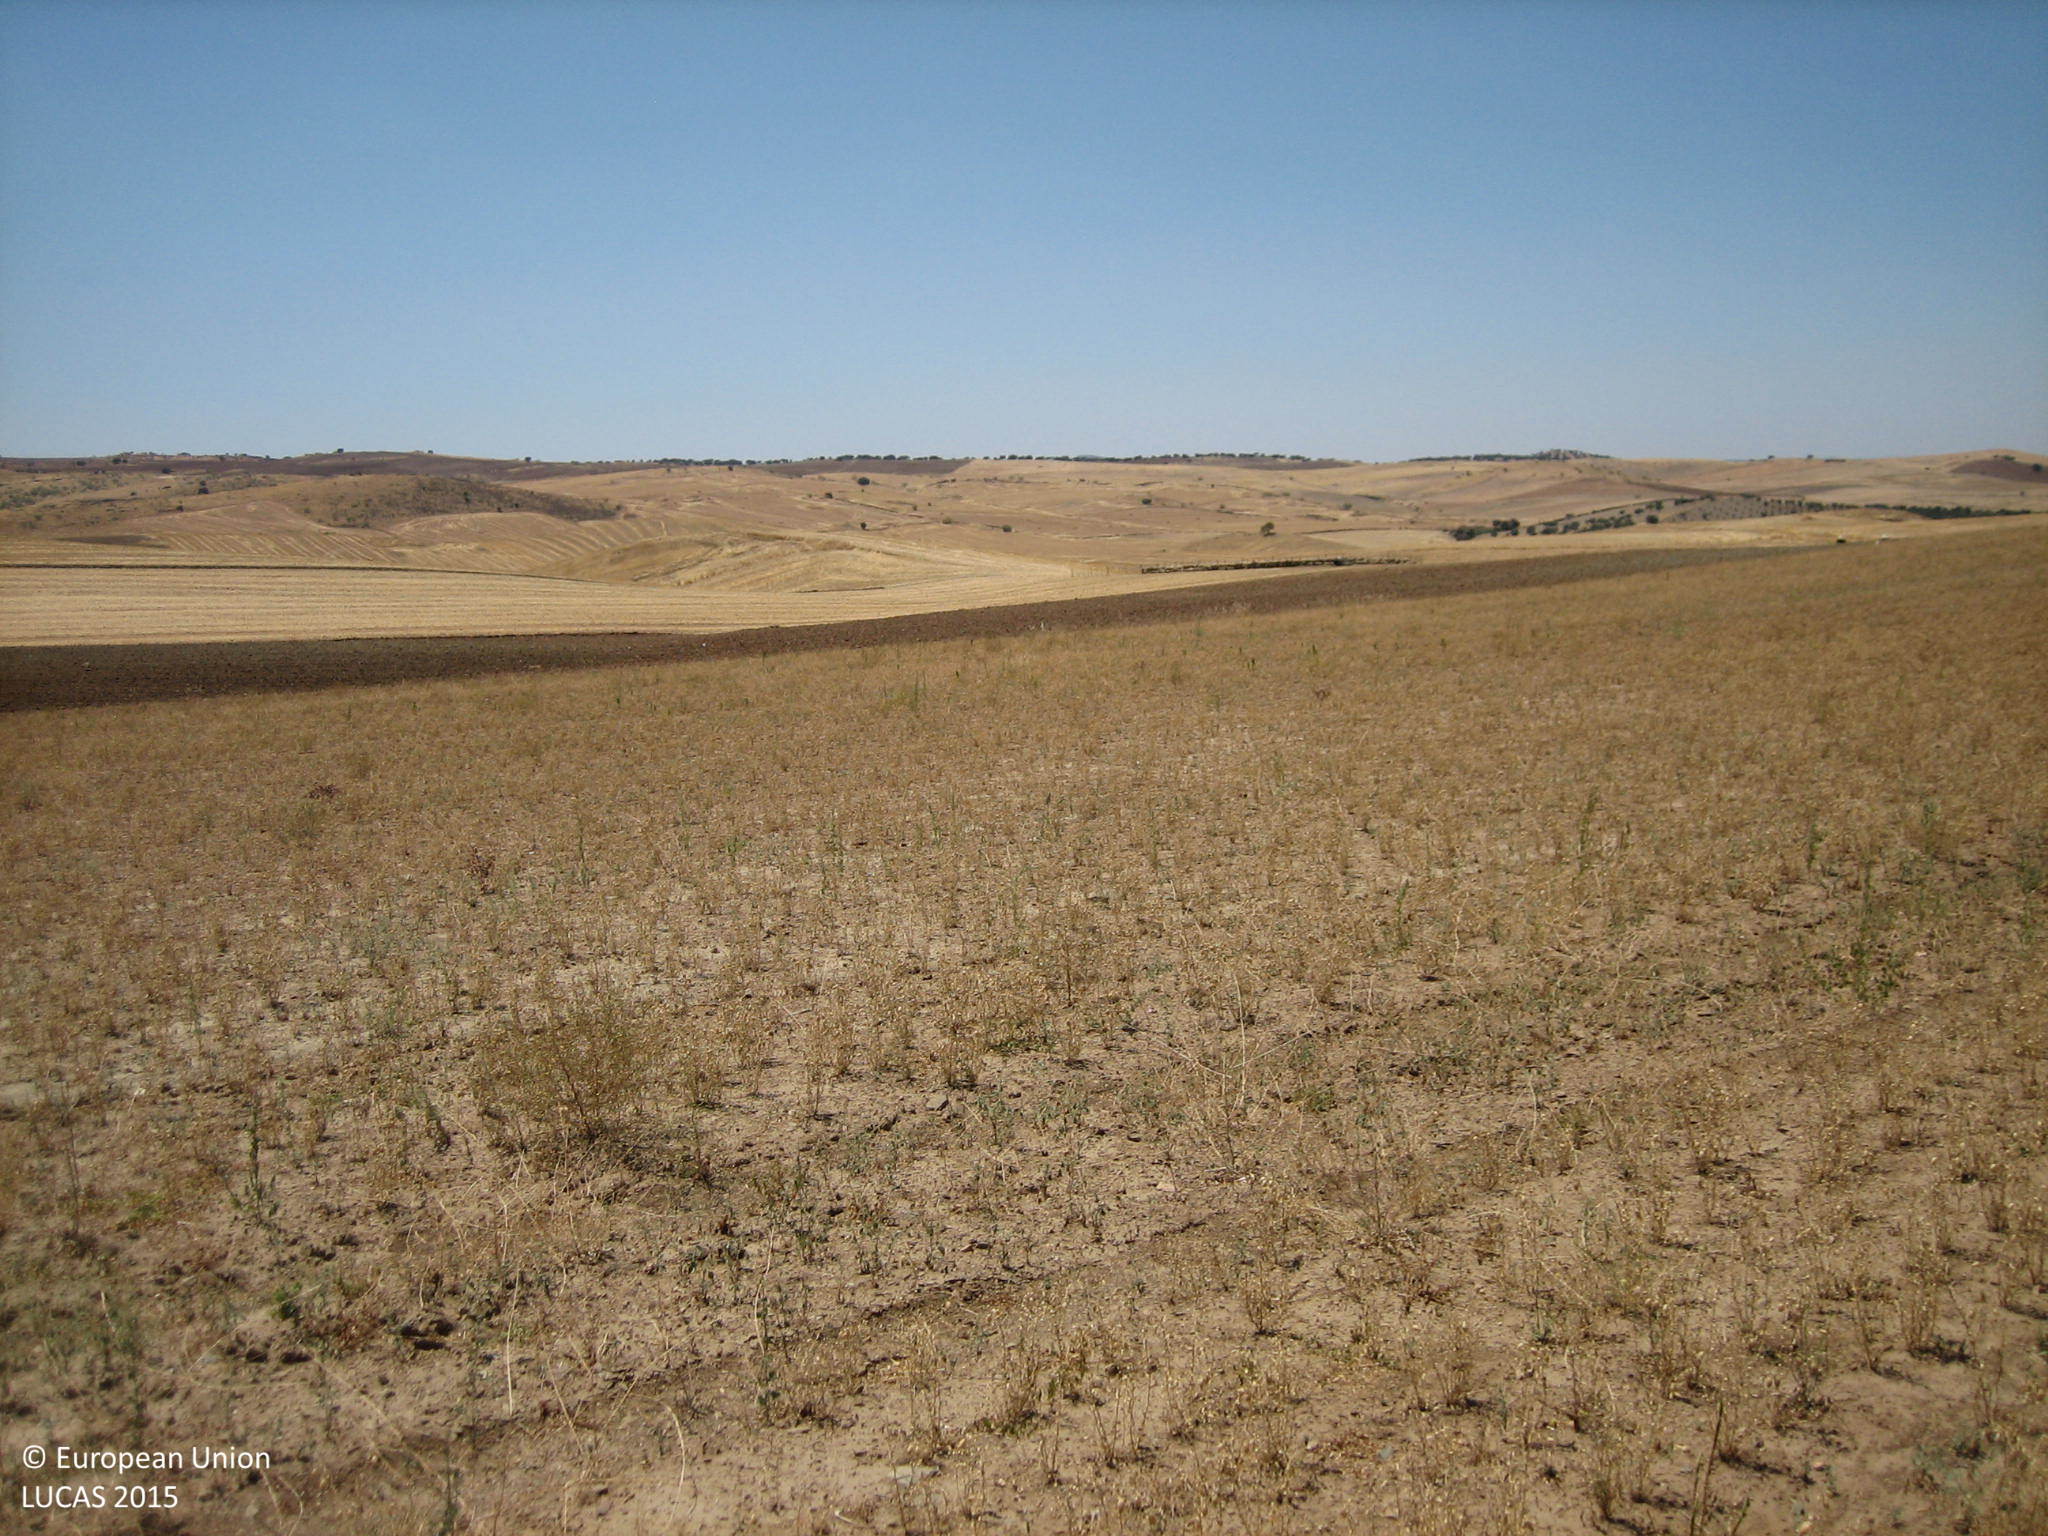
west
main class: Cropland
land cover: Dry pulses
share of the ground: 10 - 25 %
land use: Agriculture (excluding fallow land and kitchen gardens)
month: July
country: ES
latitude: 38.1774
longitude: -6.2878
